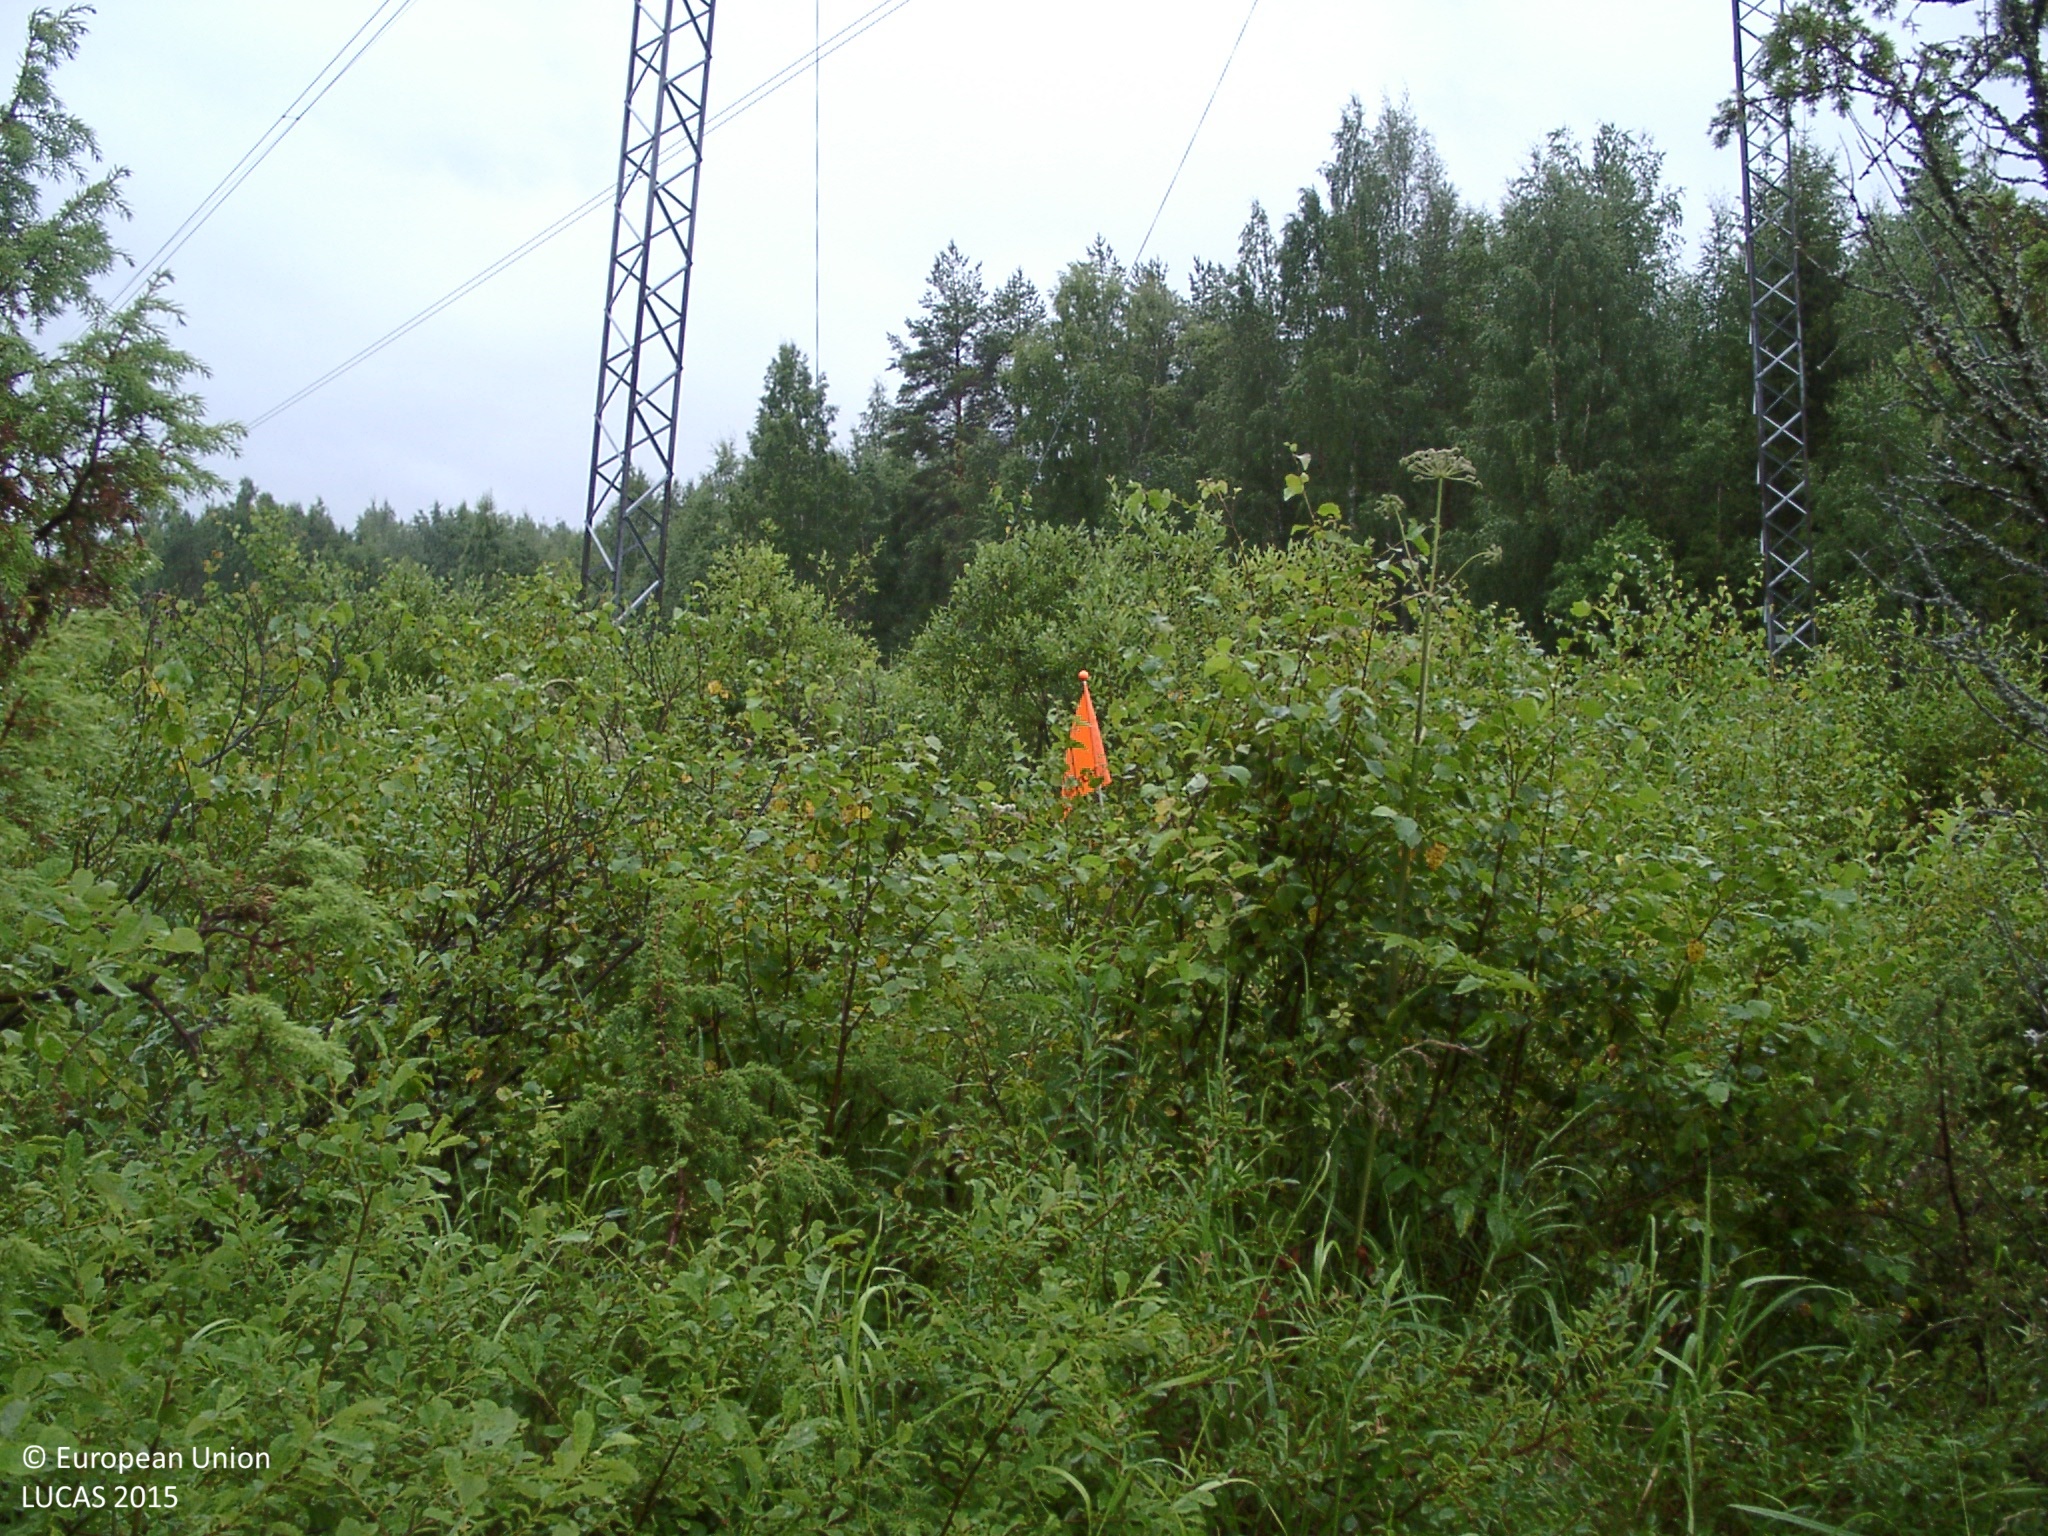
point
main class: Woodland
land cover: Broadleaved woodland
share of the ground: 25 - 50 %
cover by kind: shrubs 55 %, broadleaved forest trees 20 %, herbaceous plants 20 %, coniferous forest trees 5 %
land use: Logistics and storage
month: August
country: FI
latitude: 62.8415
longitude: 24.5203
